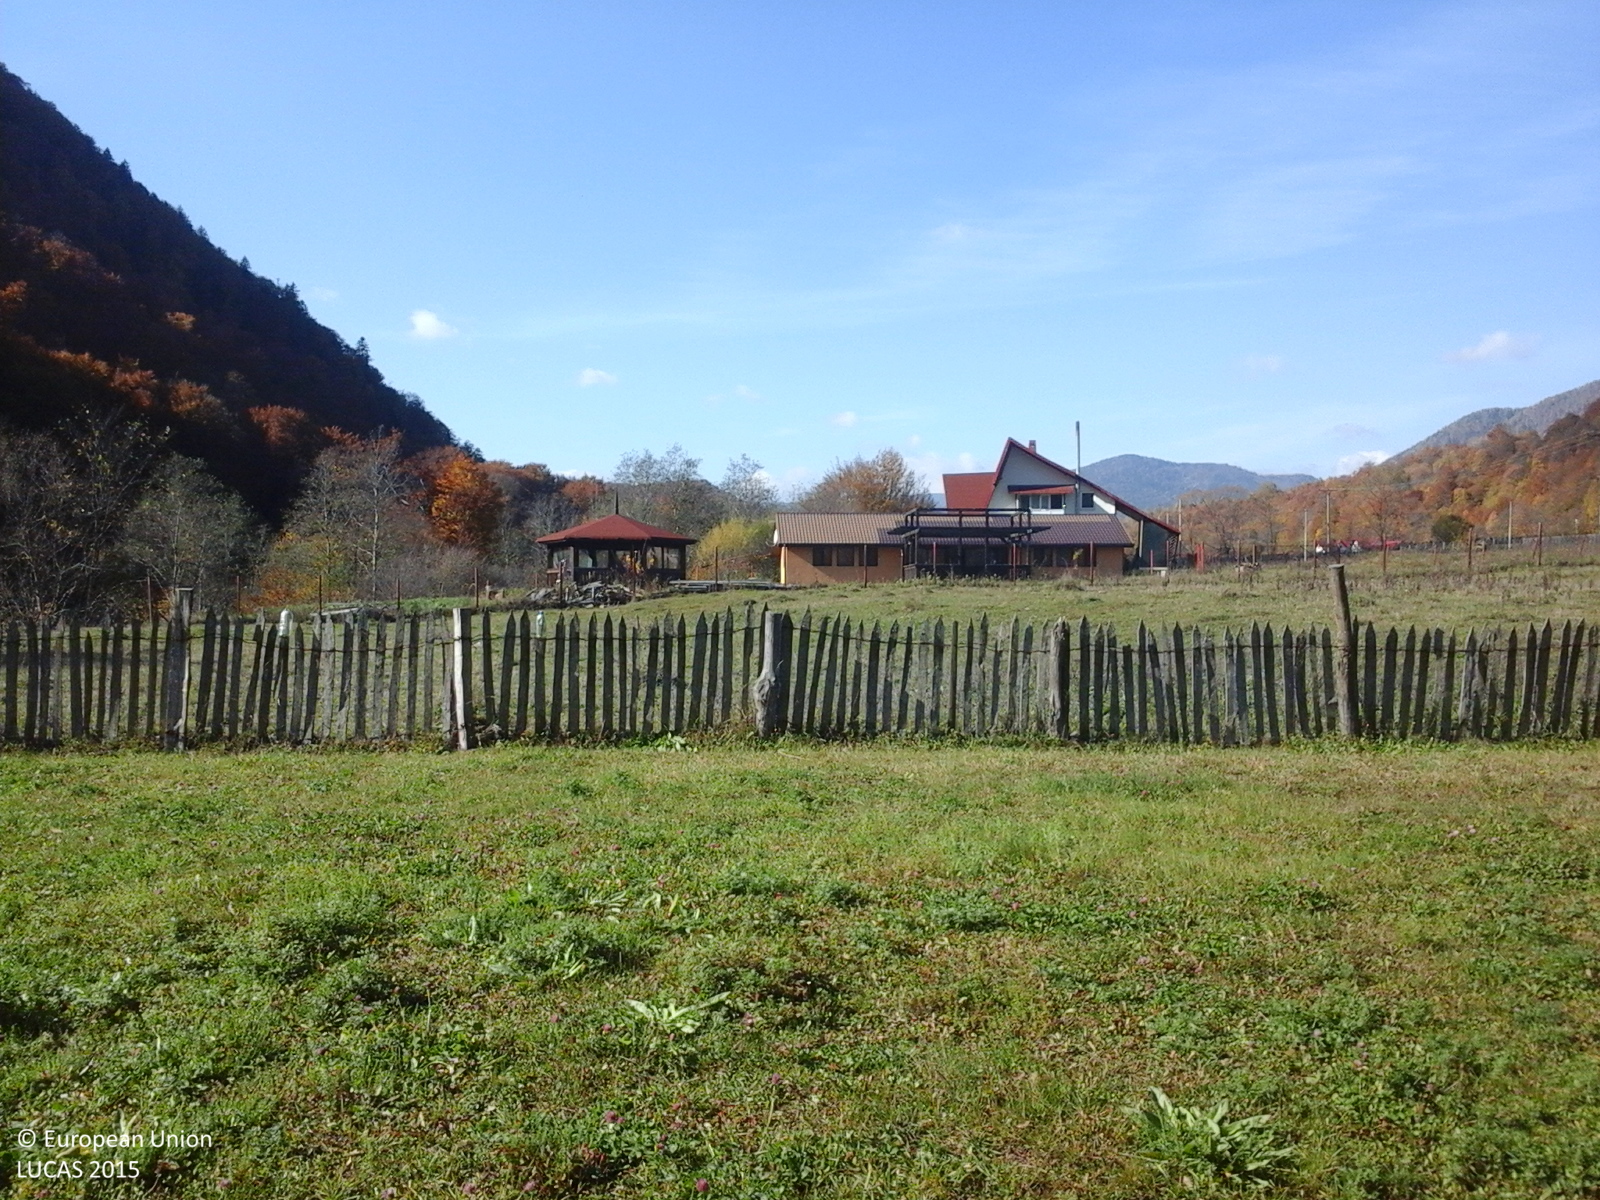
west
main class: Grassland
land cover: Grassland without tree/shrub cover
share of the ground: > 75 %
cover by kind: herbaceous plants 100 %
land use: Agriculture (excluding fallow land and kitchen gardens)
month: October
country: RO
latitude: 45.9501
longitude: 26.5537
